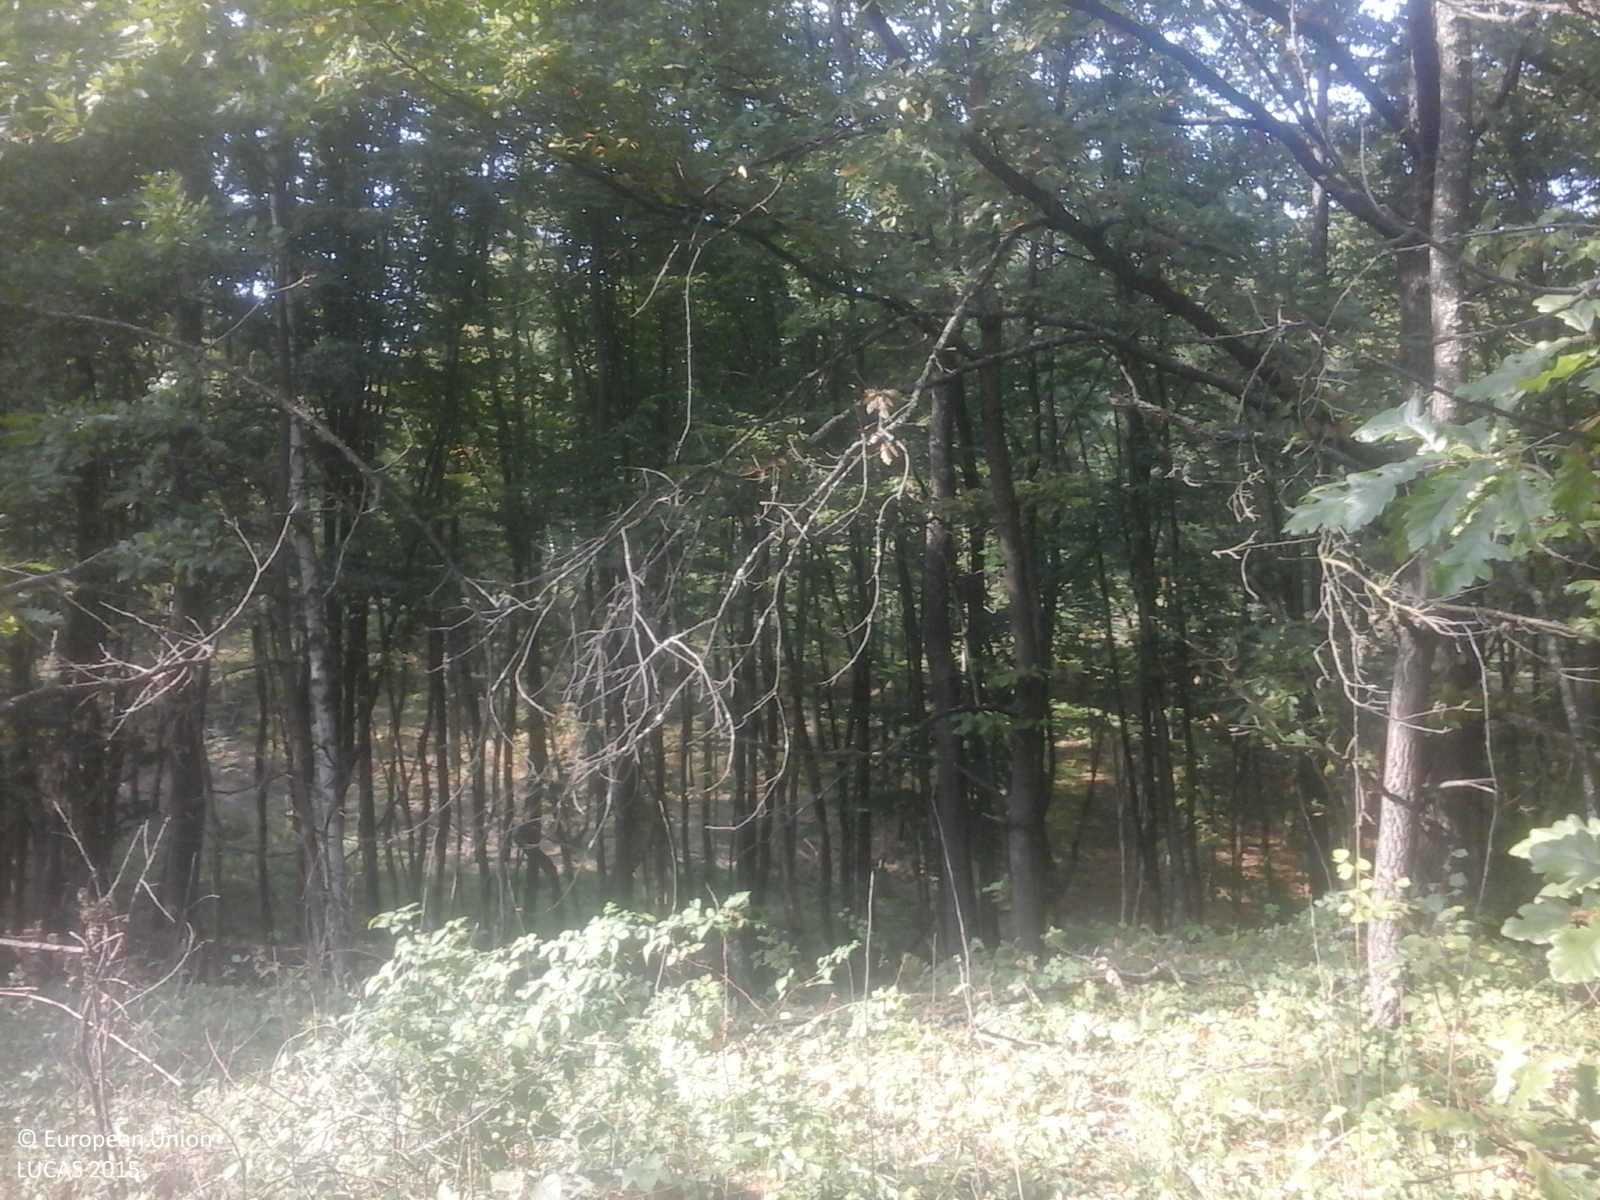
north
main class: Woodland
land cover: Broadleaved woodland
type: acidophilous oak and oak-birch forest
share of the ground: > 75 %
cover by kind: broadleaved forest trees 100 %
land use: Forestry
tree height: > 5 m
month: September
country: RO
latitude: 45.8841
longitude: 22.3775
